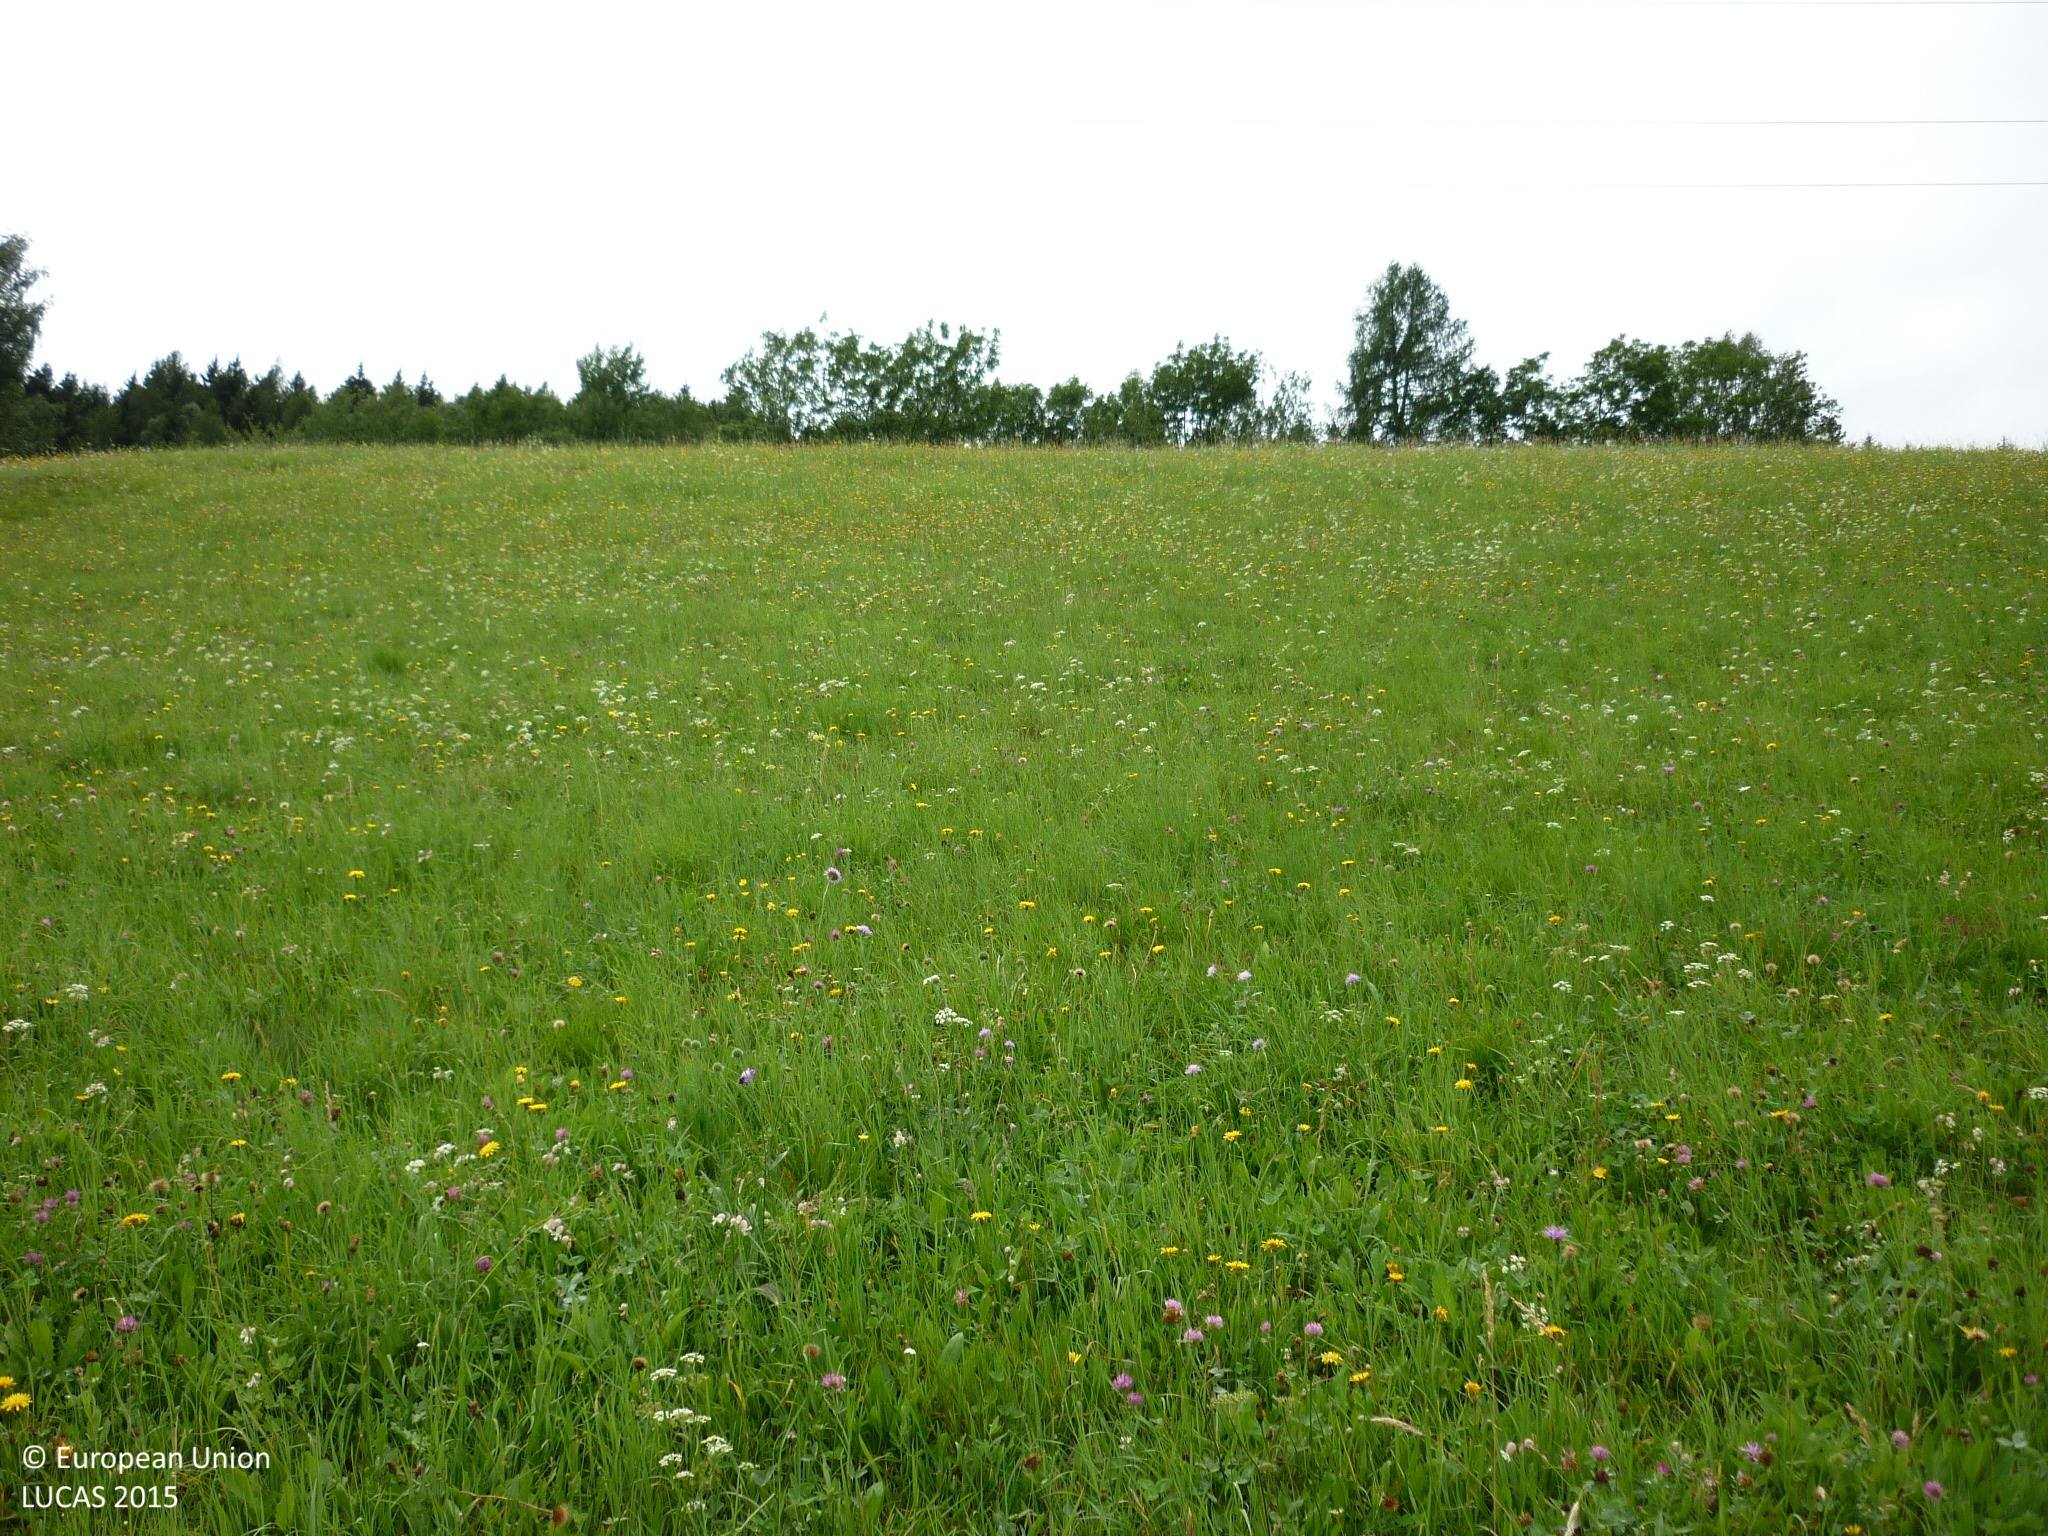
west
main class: Grassland
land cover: Grassland without tree/shrub cover
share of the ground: > 75 %
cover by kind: herbaceous plants 100 %
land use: Agriculture (excluding fallow land and kitchen gardens)
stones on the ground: < 10 %
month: August
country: AT
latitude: 46.8708
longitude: 13.5005
